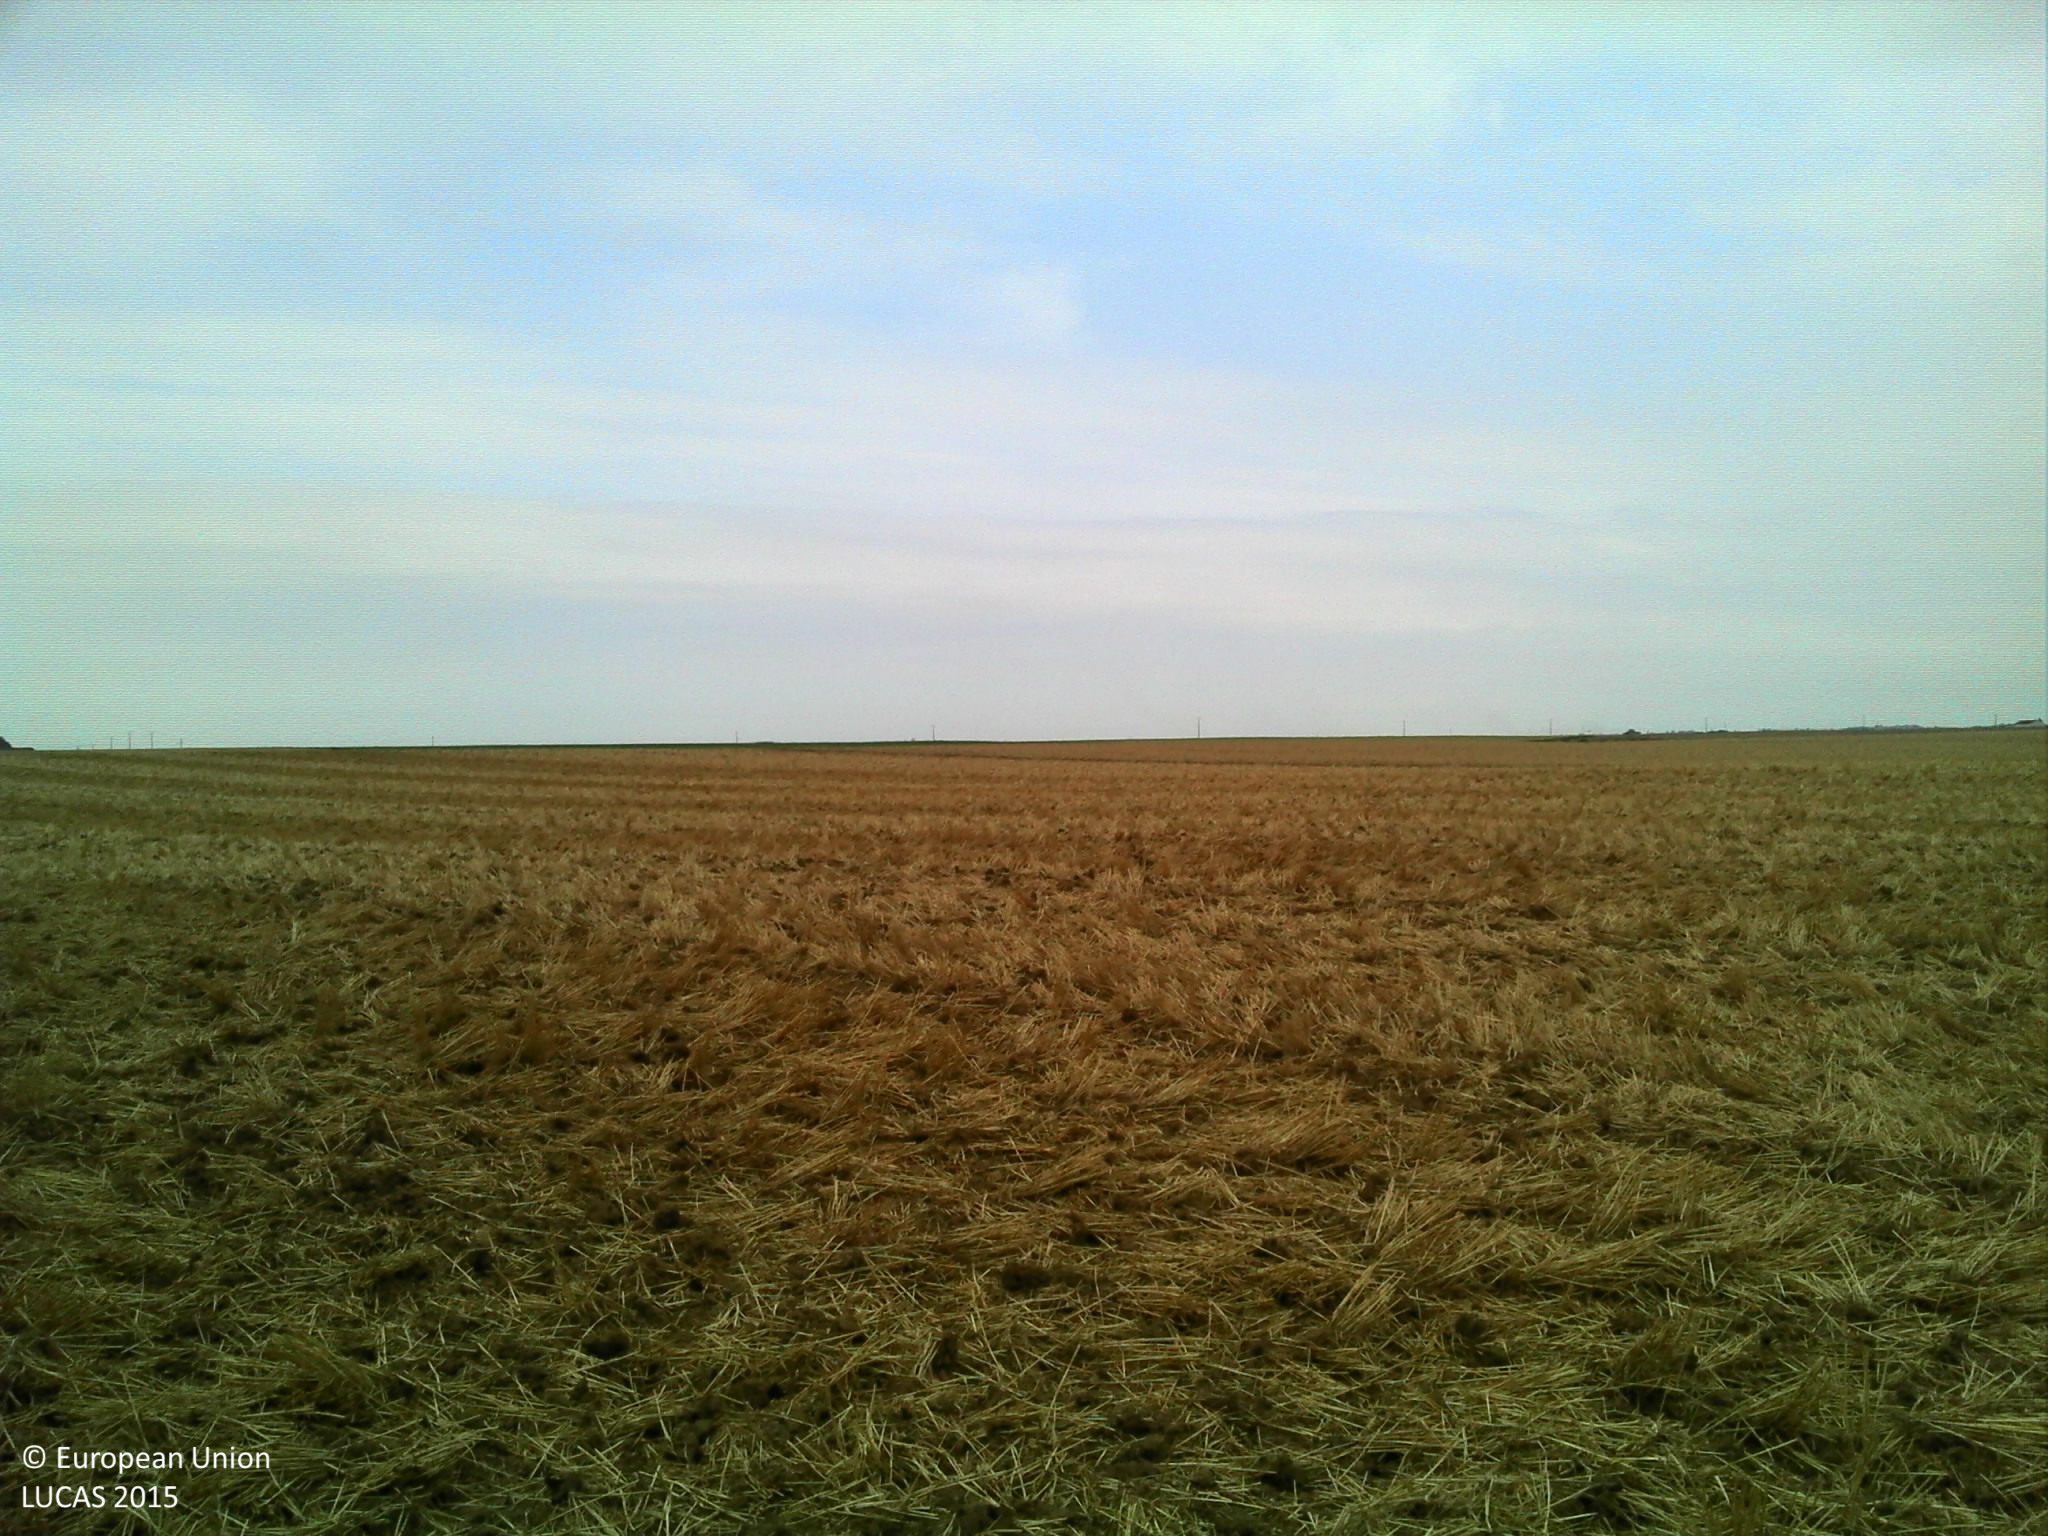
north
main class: Cropland
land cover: Common wheat
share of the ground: 10 - 25 %
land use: Agriculture (excluding fallow land and kitchen gardens)
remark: Harvested field
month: August
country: FR
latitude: 48.2419
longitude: 2.5437
